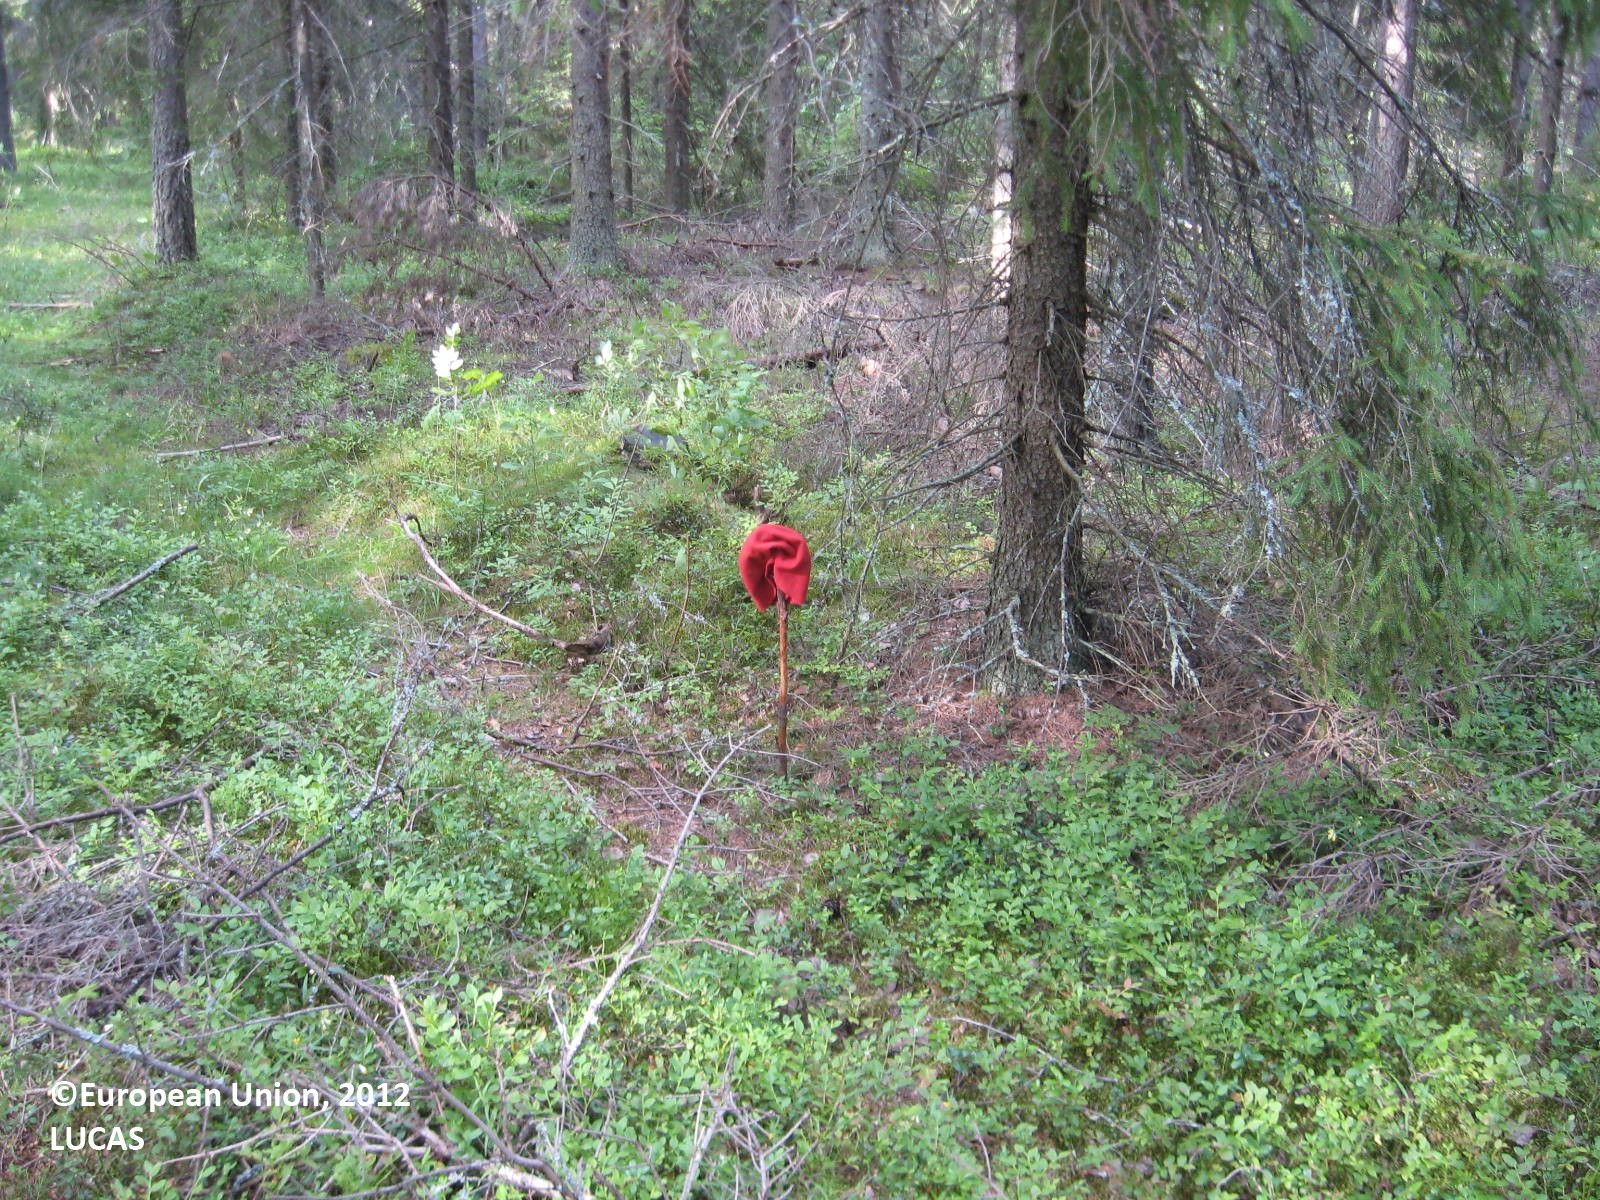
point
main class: Woodland
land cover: Spruce dominated coniferous woodland
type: boreal forest
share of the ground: > 75 %
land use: Forestry
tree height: > 5 m
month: July
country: FI
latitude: 62.0396
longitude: 21.5374
